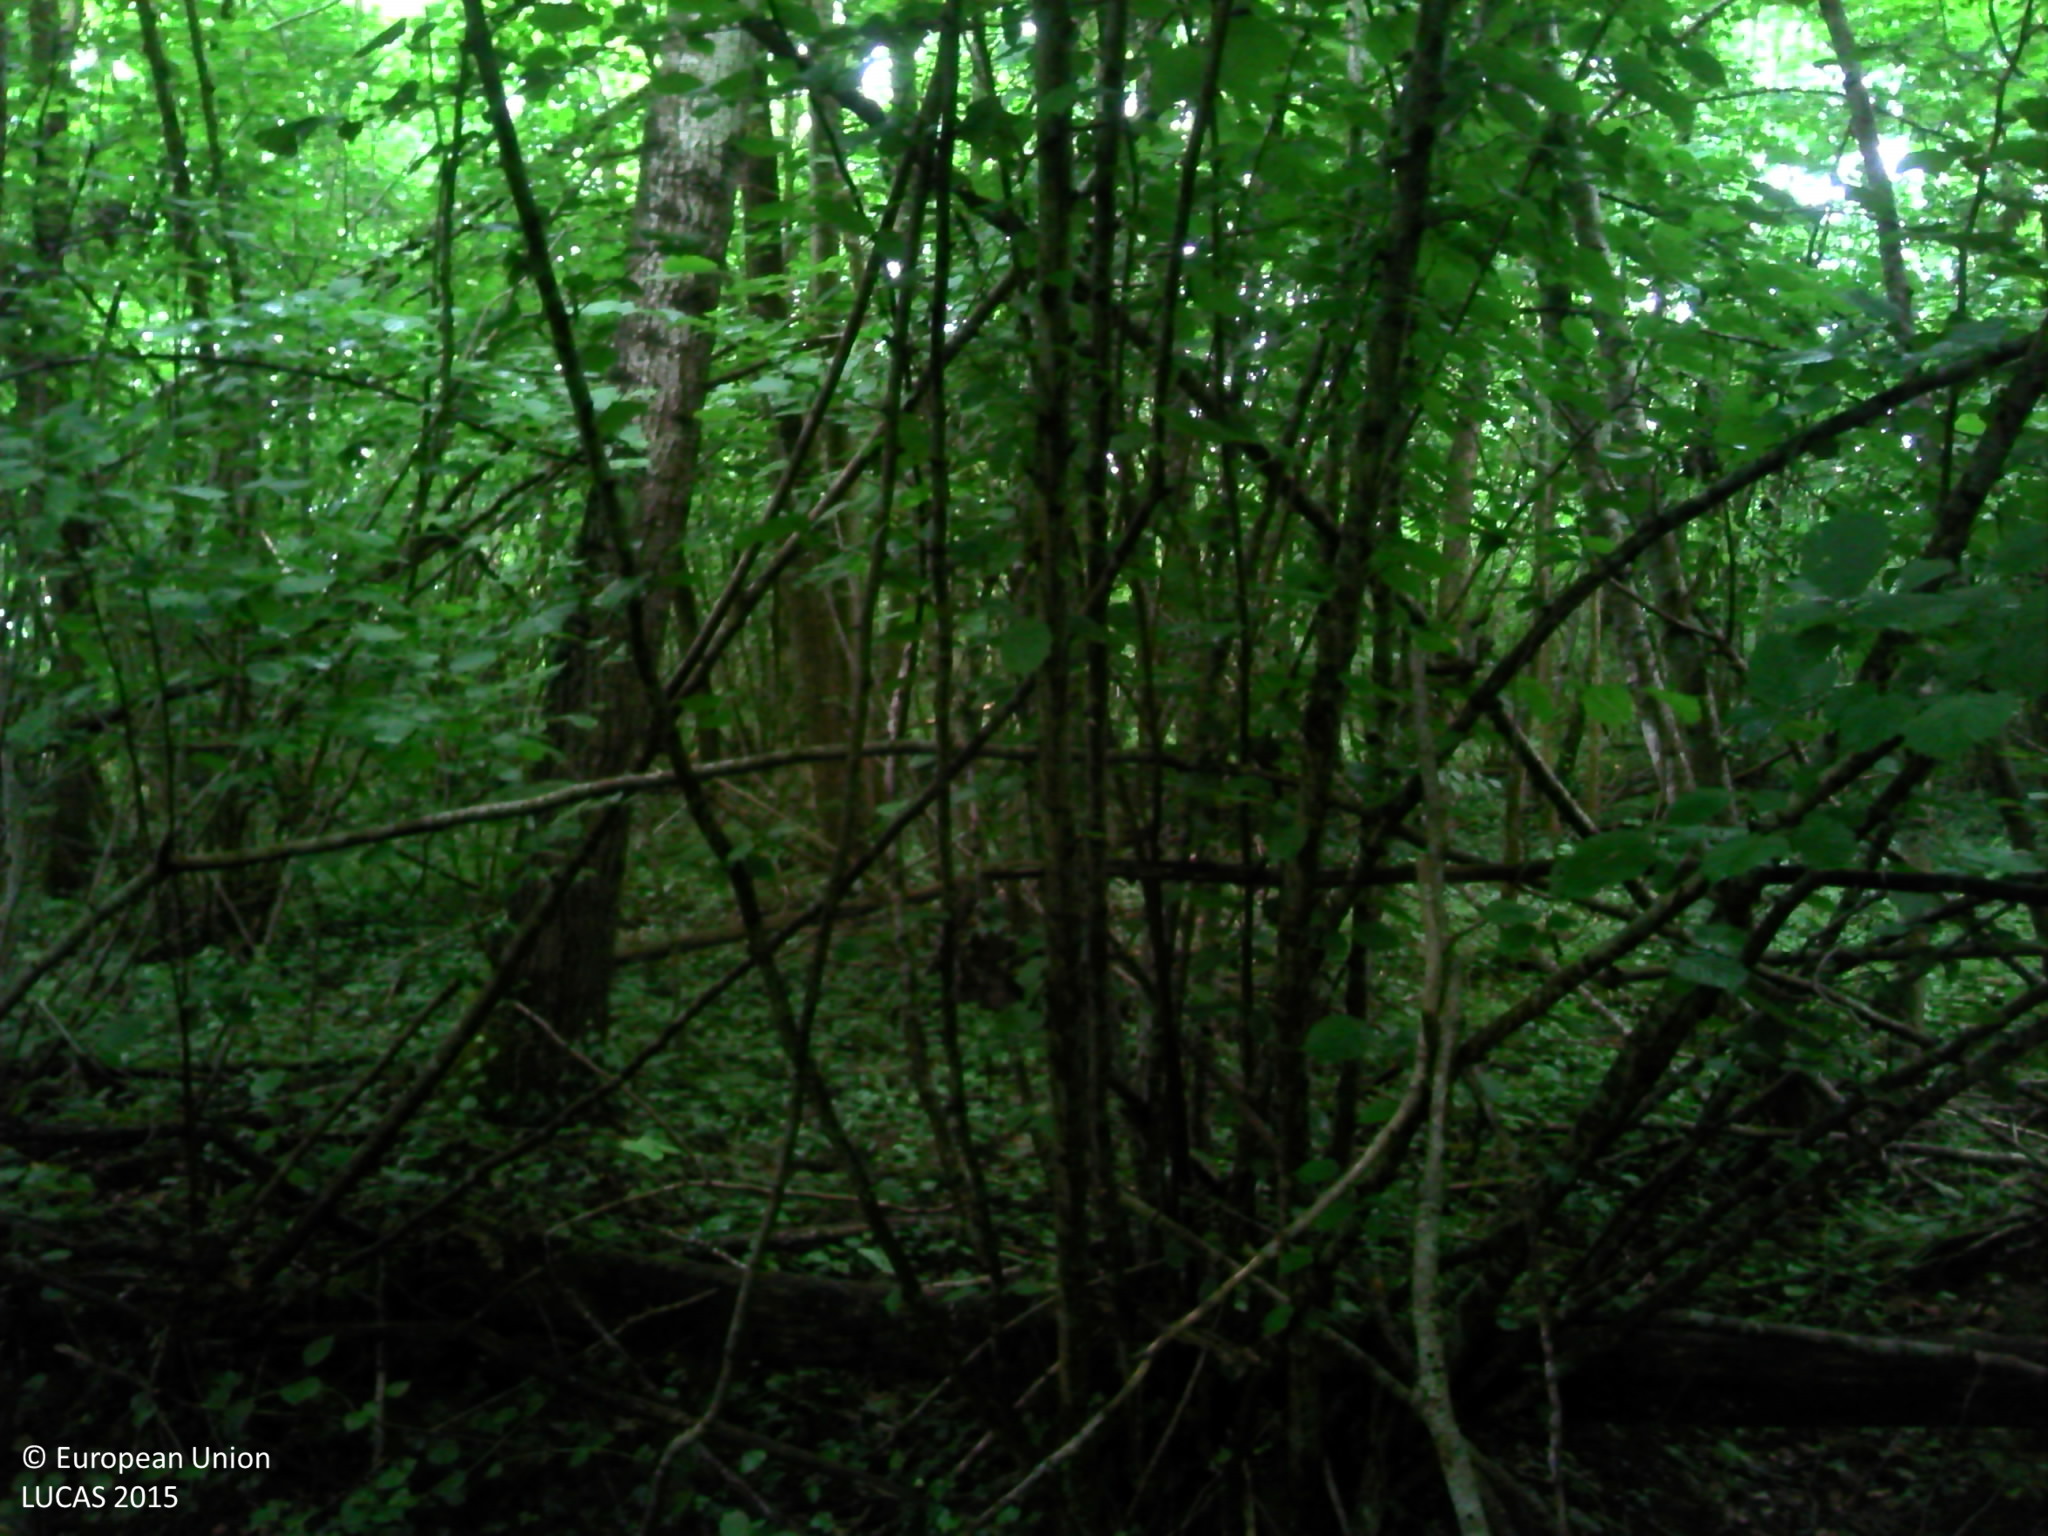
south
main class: Woodland
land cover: Broadleaved woodland
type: mesophytic deciduous forest
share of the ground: > 75 %
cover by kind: broadleaved forest trees 90 %, herbaceous plants 10 %
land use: Forestry
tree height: > 5 m
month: June
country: FR
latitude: 46.6285
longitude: 5.3395
